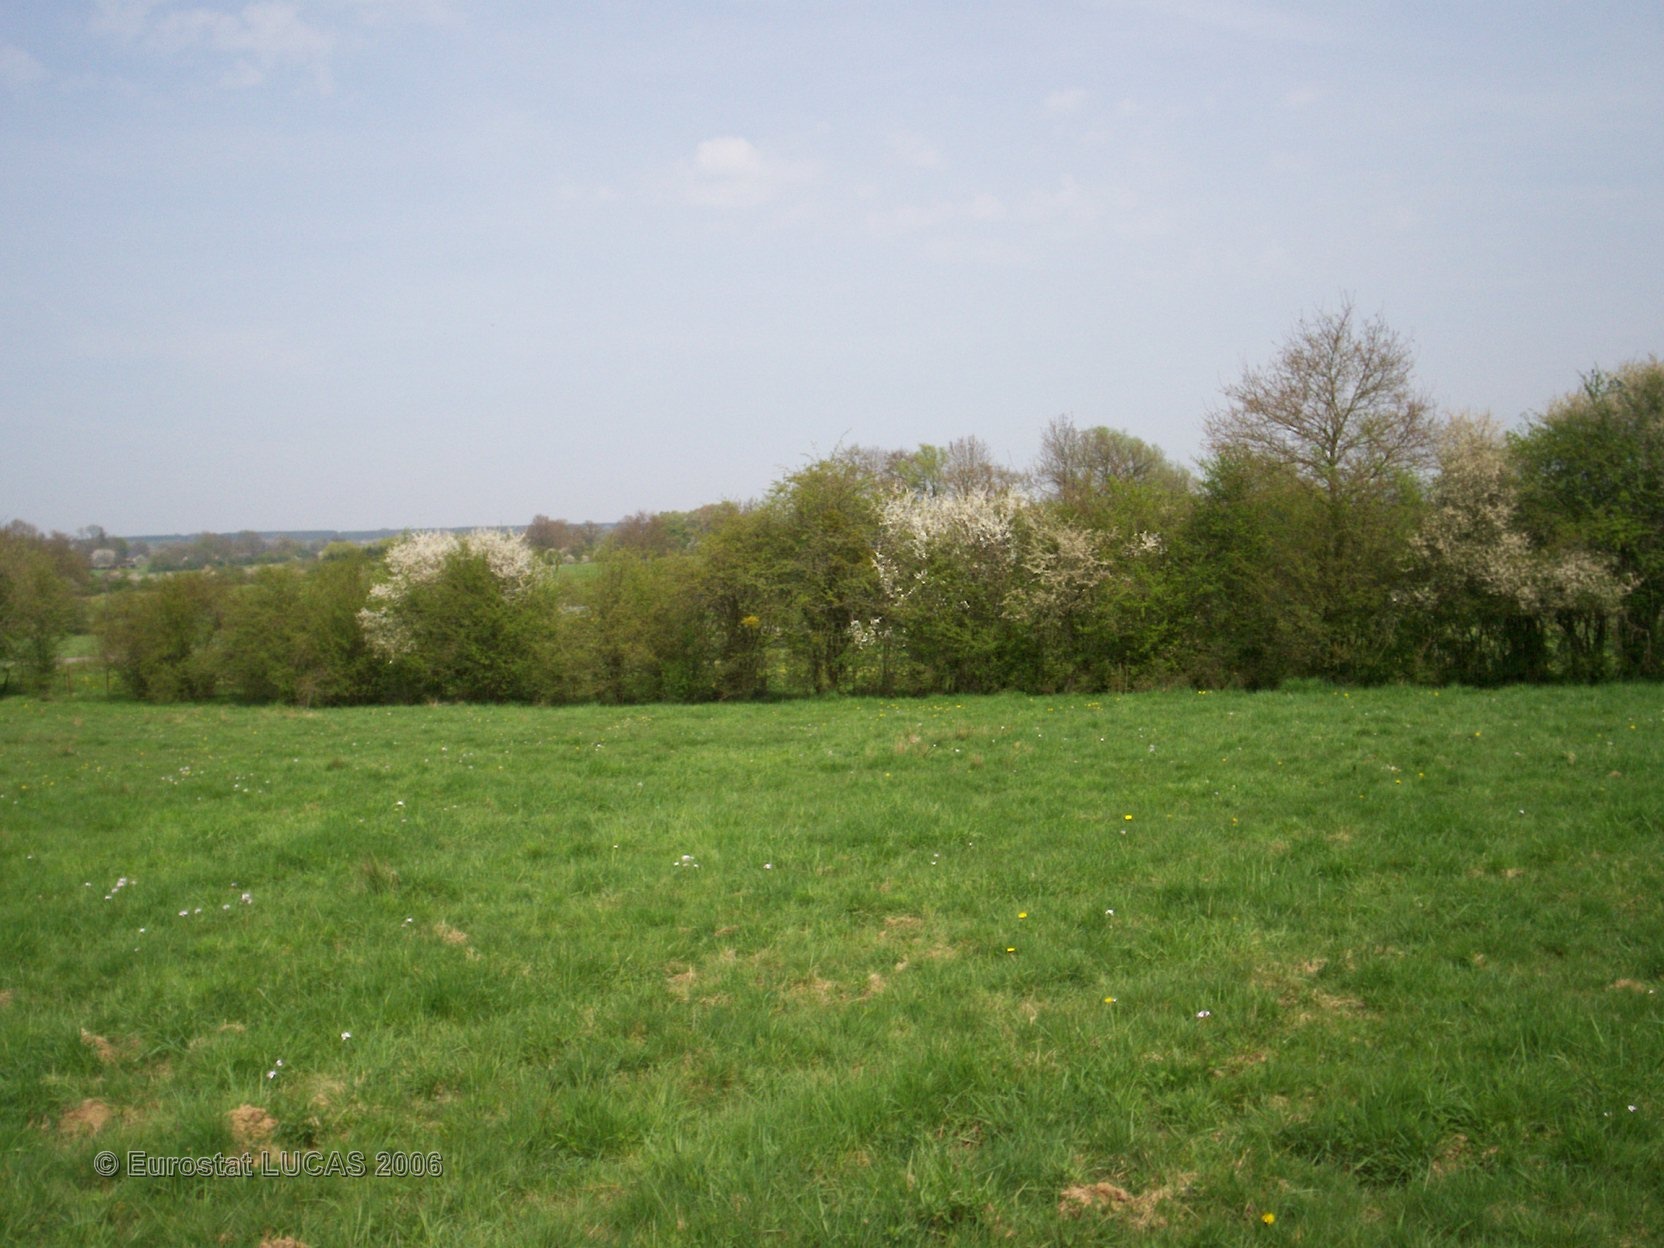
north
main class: Grassland
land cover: Grassland without tree/shrub cover
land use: Agriculture (excluding fallow land and kitchen gardens)
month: May
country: FR
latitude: 49.8796
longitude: 4.3037
